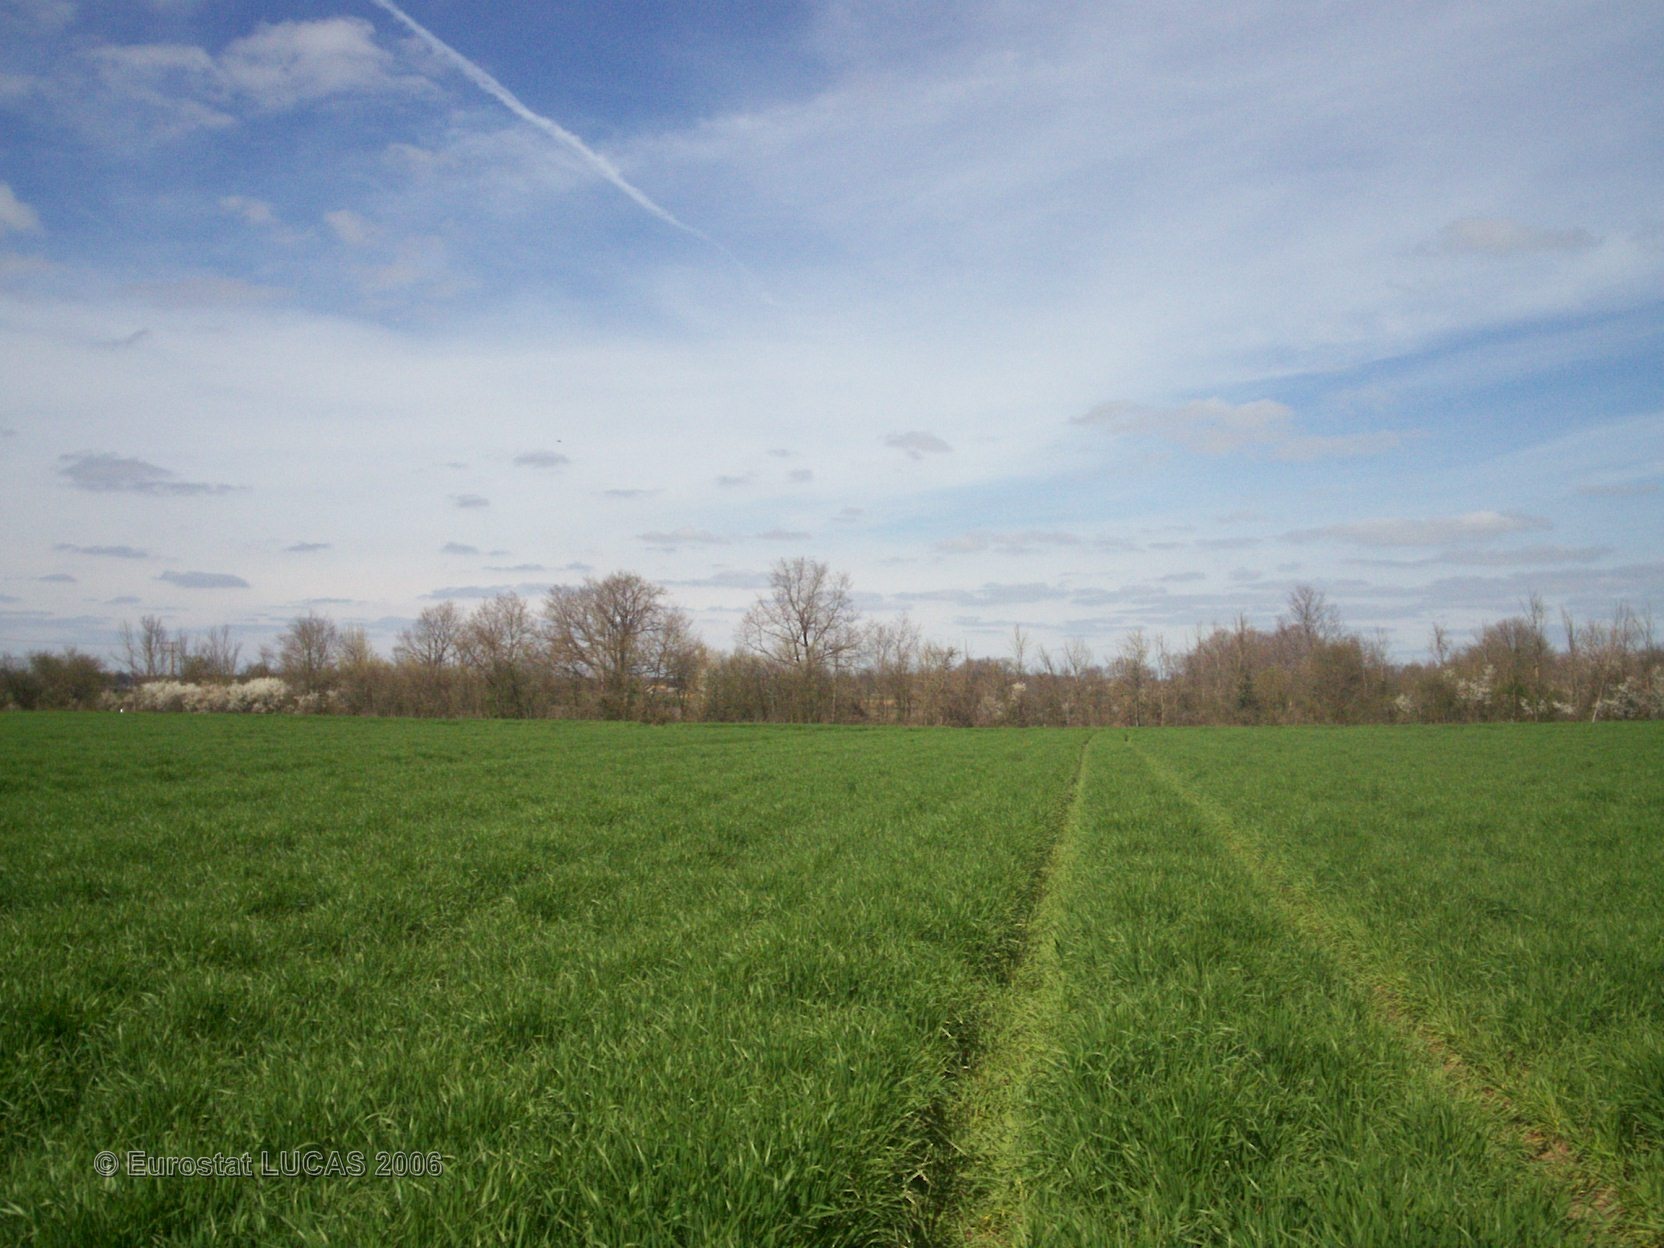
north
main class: Cropland
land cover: Barley
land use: Agriculture (excluding fallow land and kitchen gardens)
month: April
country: FR
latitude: 46.4347
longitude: 0.4951
